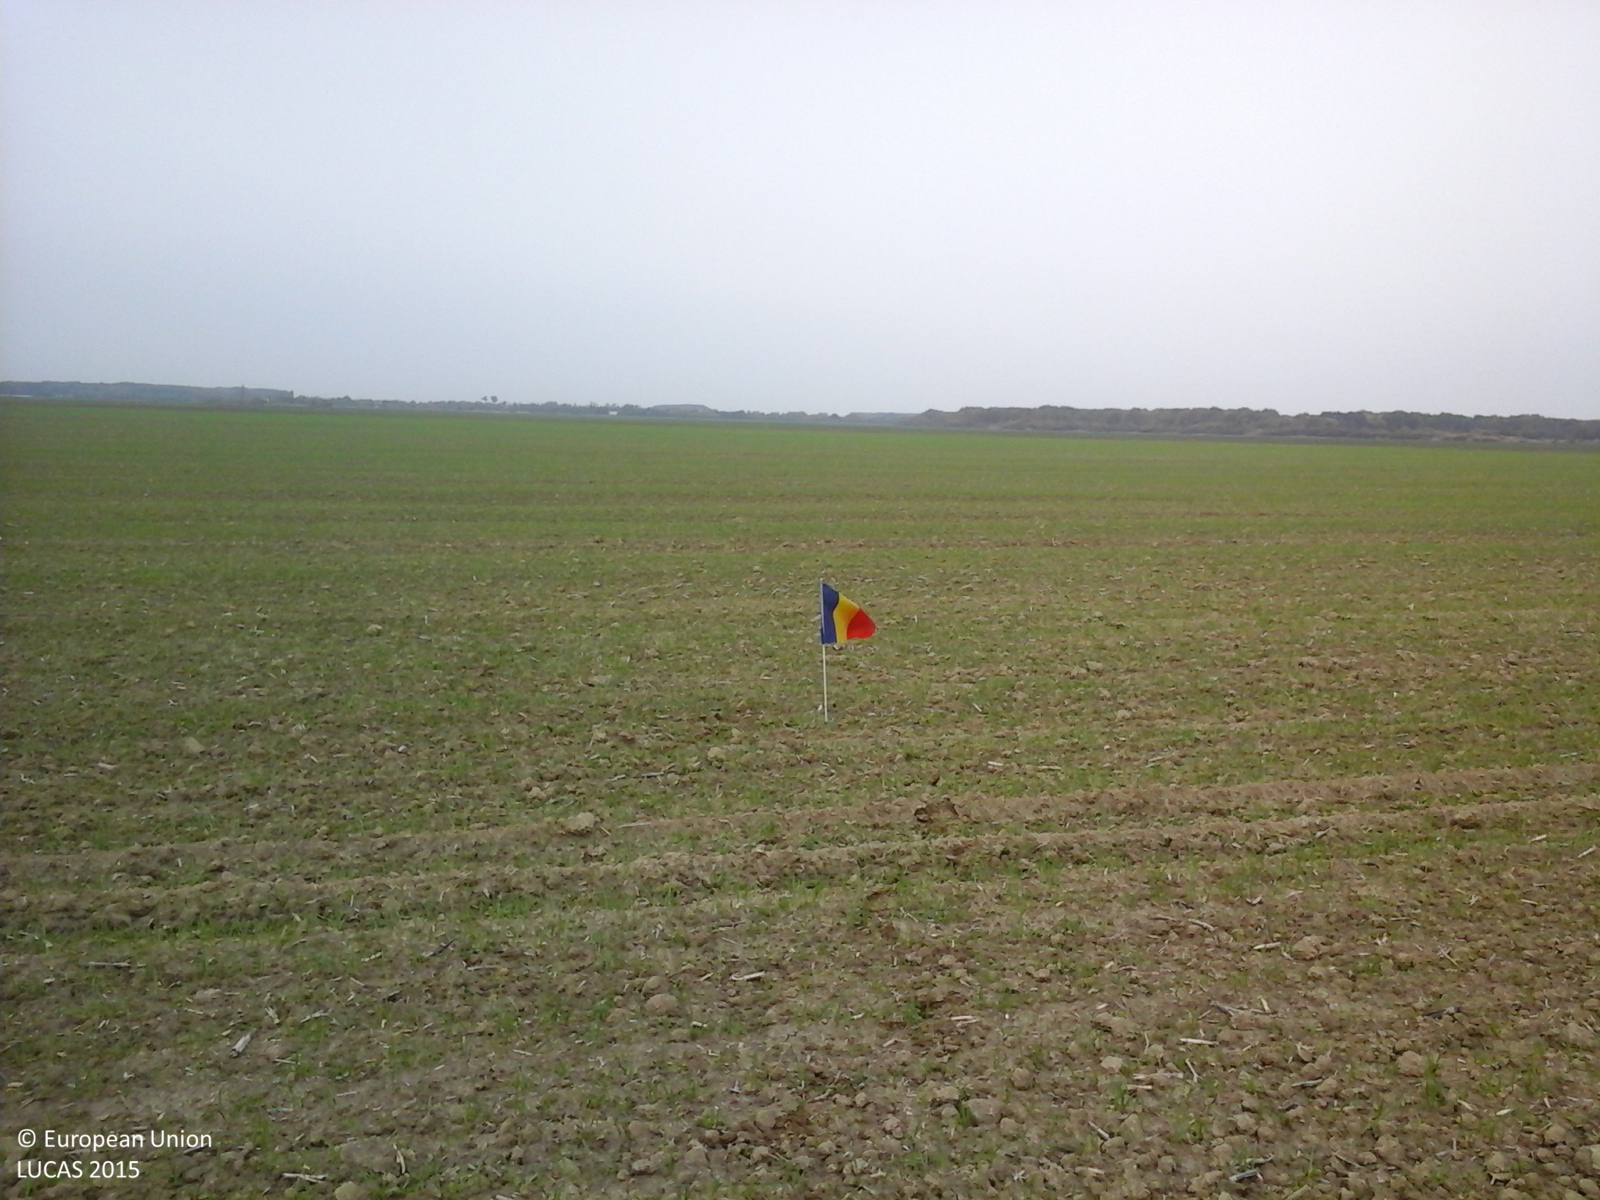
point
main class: Cropland
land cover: Common wheat
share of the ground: 25 - 50 %
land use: Agriculture (excluding fallow land and kitchen gardens)
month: October
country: RO
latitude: 44.8264
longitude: 26.3420
